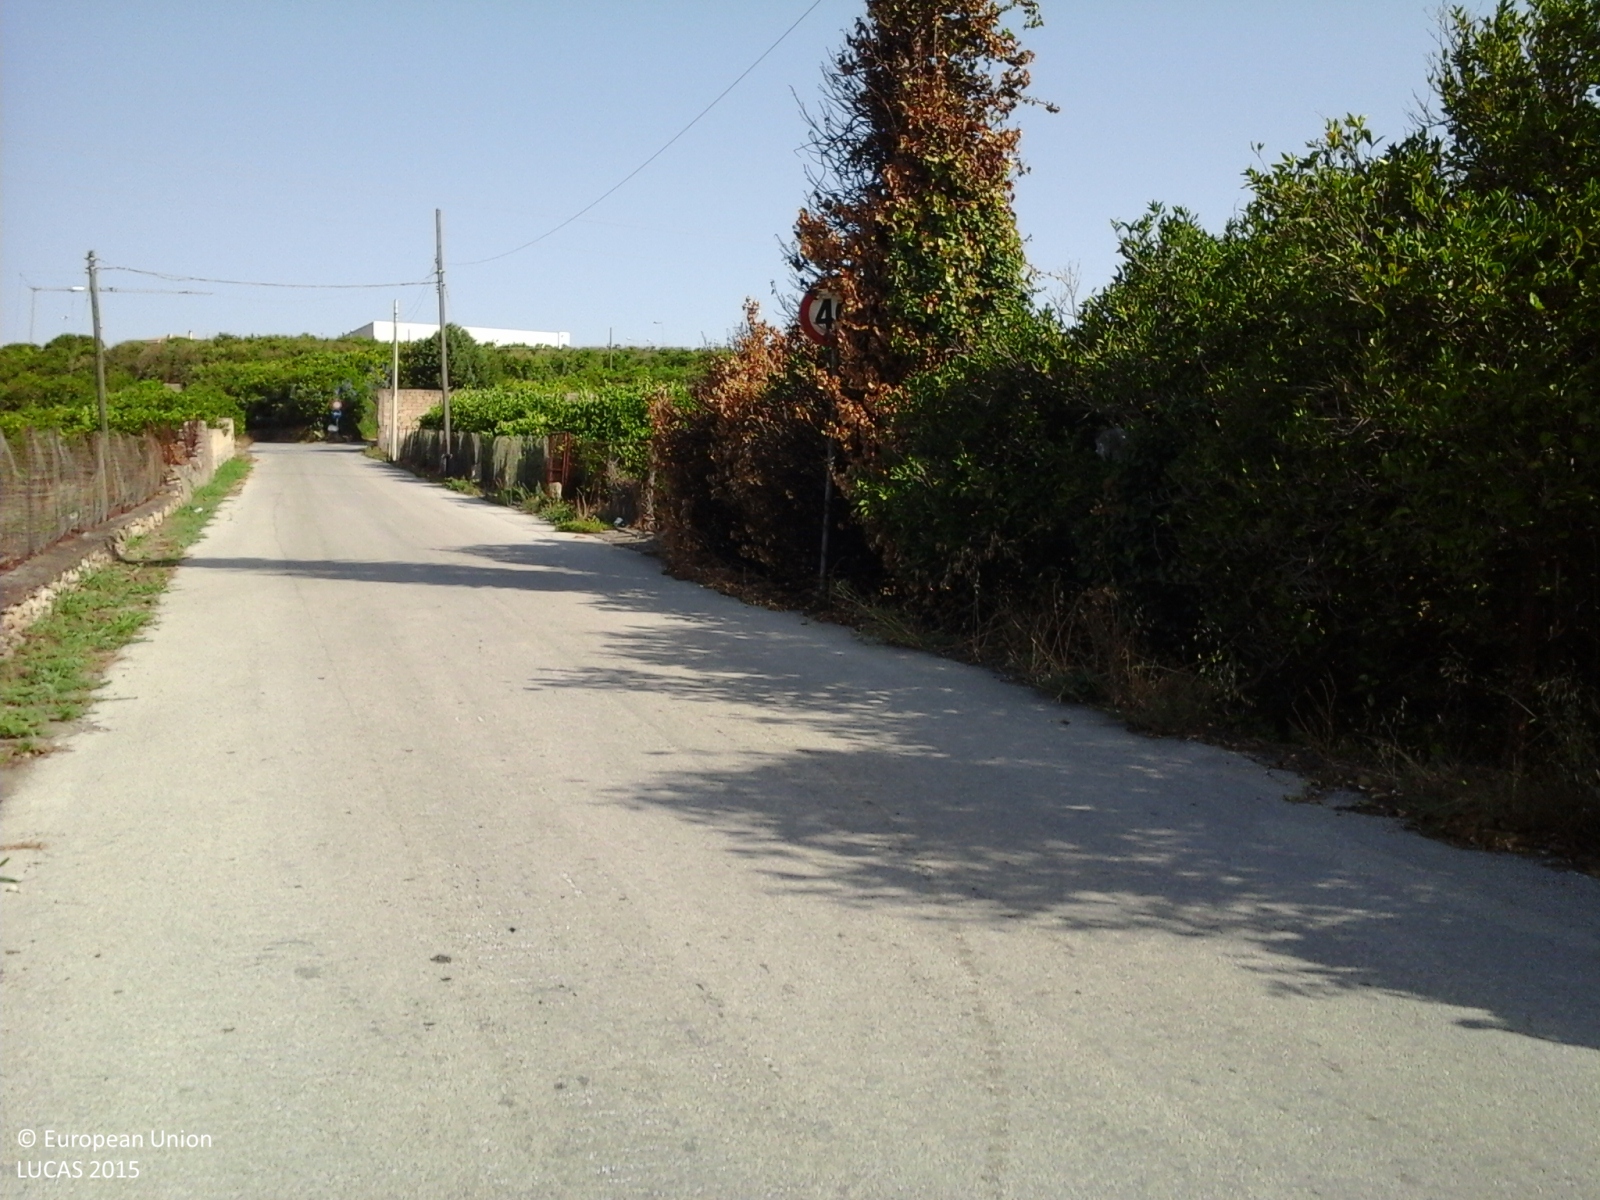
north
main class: Cropland
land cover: Oranges
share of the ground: > 75 %
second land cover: Spontaneously vegetated surfaces
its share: > 75 %
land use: Agriculture (excluding fallow land and kitchen gardens)
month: August
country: IT
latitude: 37.2217
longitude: 14.8880
